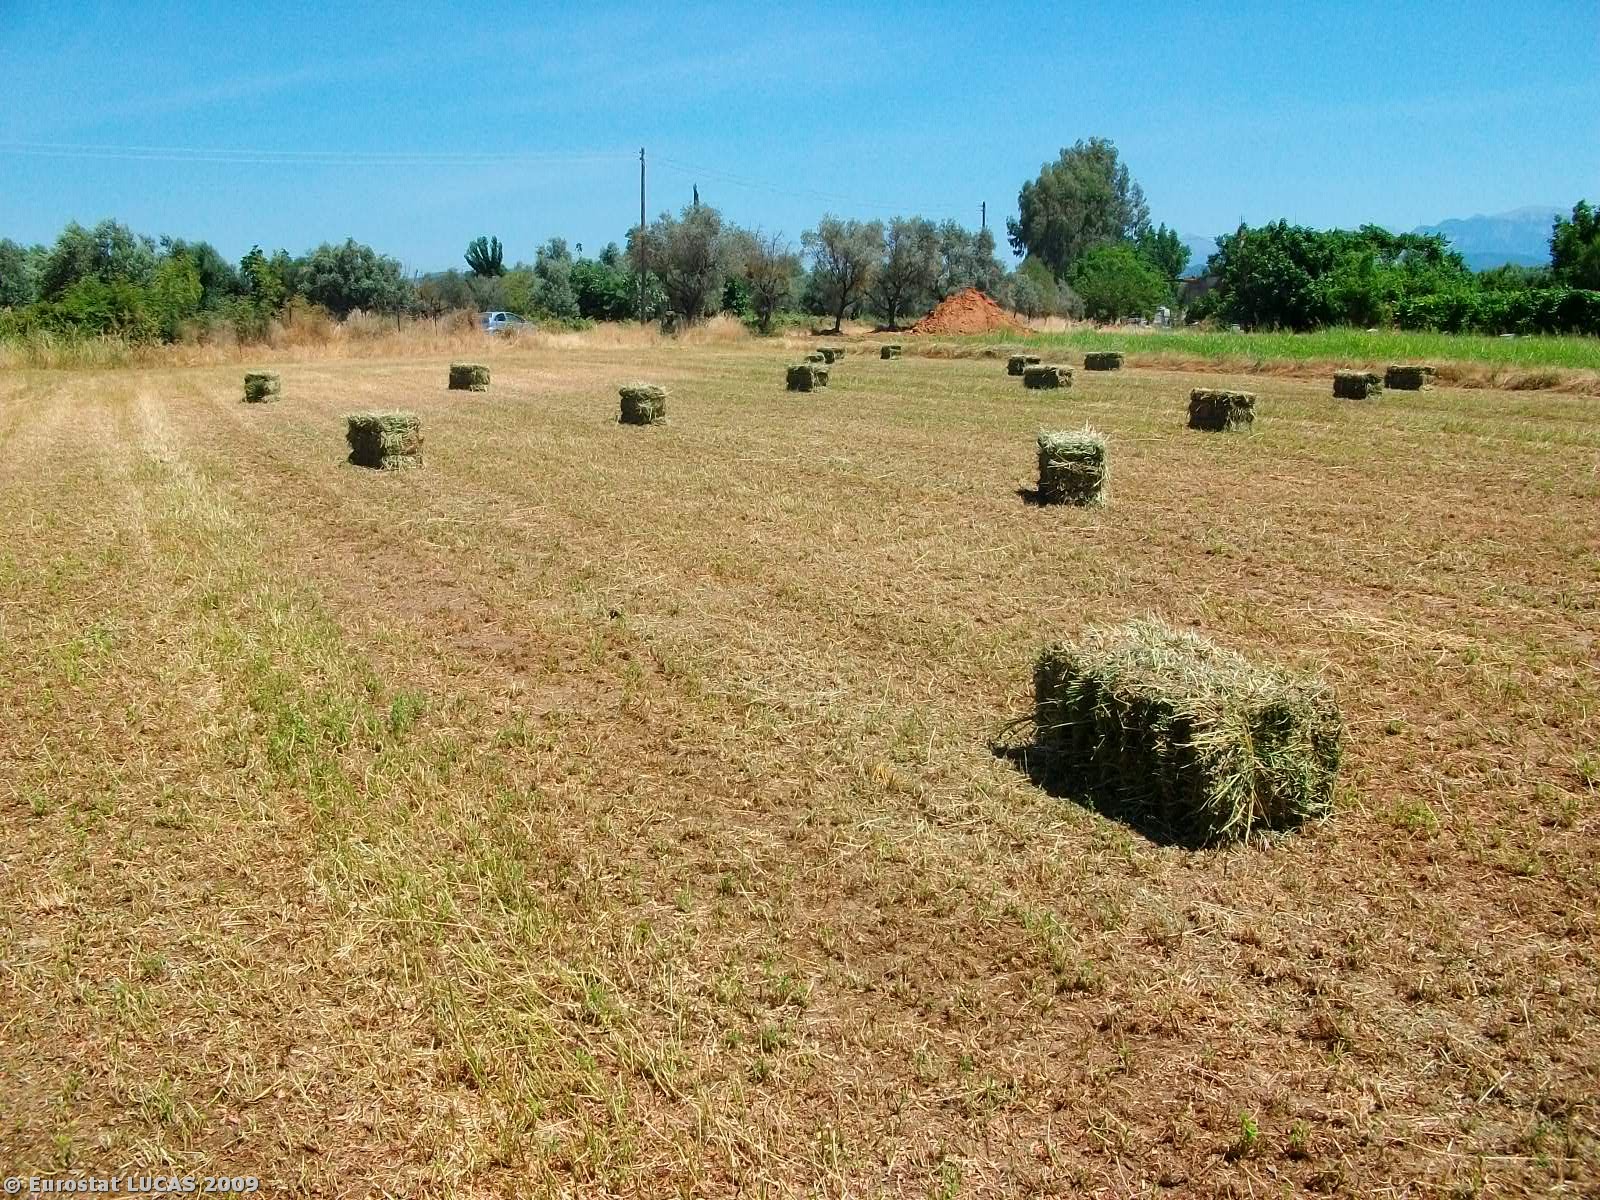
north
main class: Cropland
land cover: Lucerne
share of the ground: > 75 %
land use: Agriculture (excluding fallow land and kitchen gardens)
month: June
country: GR
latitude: 38.5733
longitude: 21.4361
